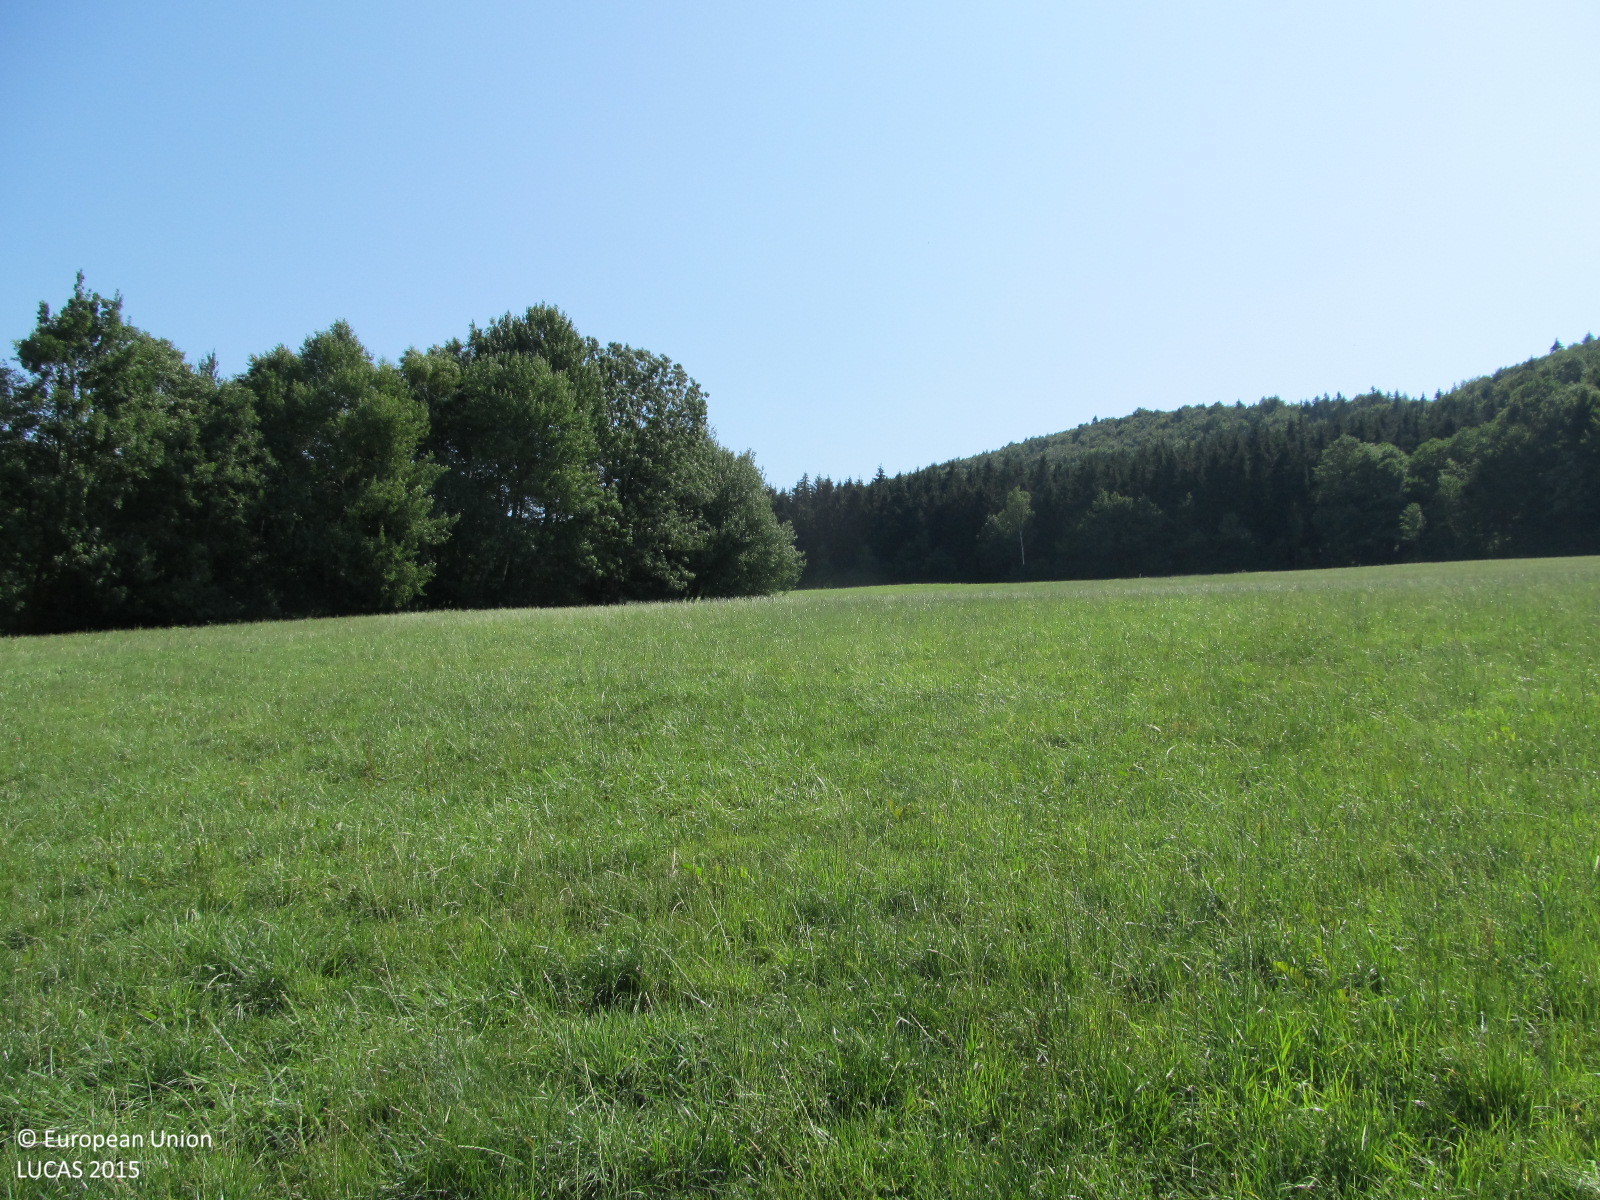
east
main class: Grassland
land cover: Grassland without tree/shrub cover
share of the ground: > 75 %
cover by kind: herbaceous plants 100 %
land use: Agriculture (excluding fallow land and kitchen gardens)
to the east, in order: Grassland without tree/shrub cover; Paved roads, cycling and walking lanes; Grass margins; Ditches and canals; Spruce dominated mixed woodland
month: August
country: AT
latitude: 48.0729
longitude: 15.7606
